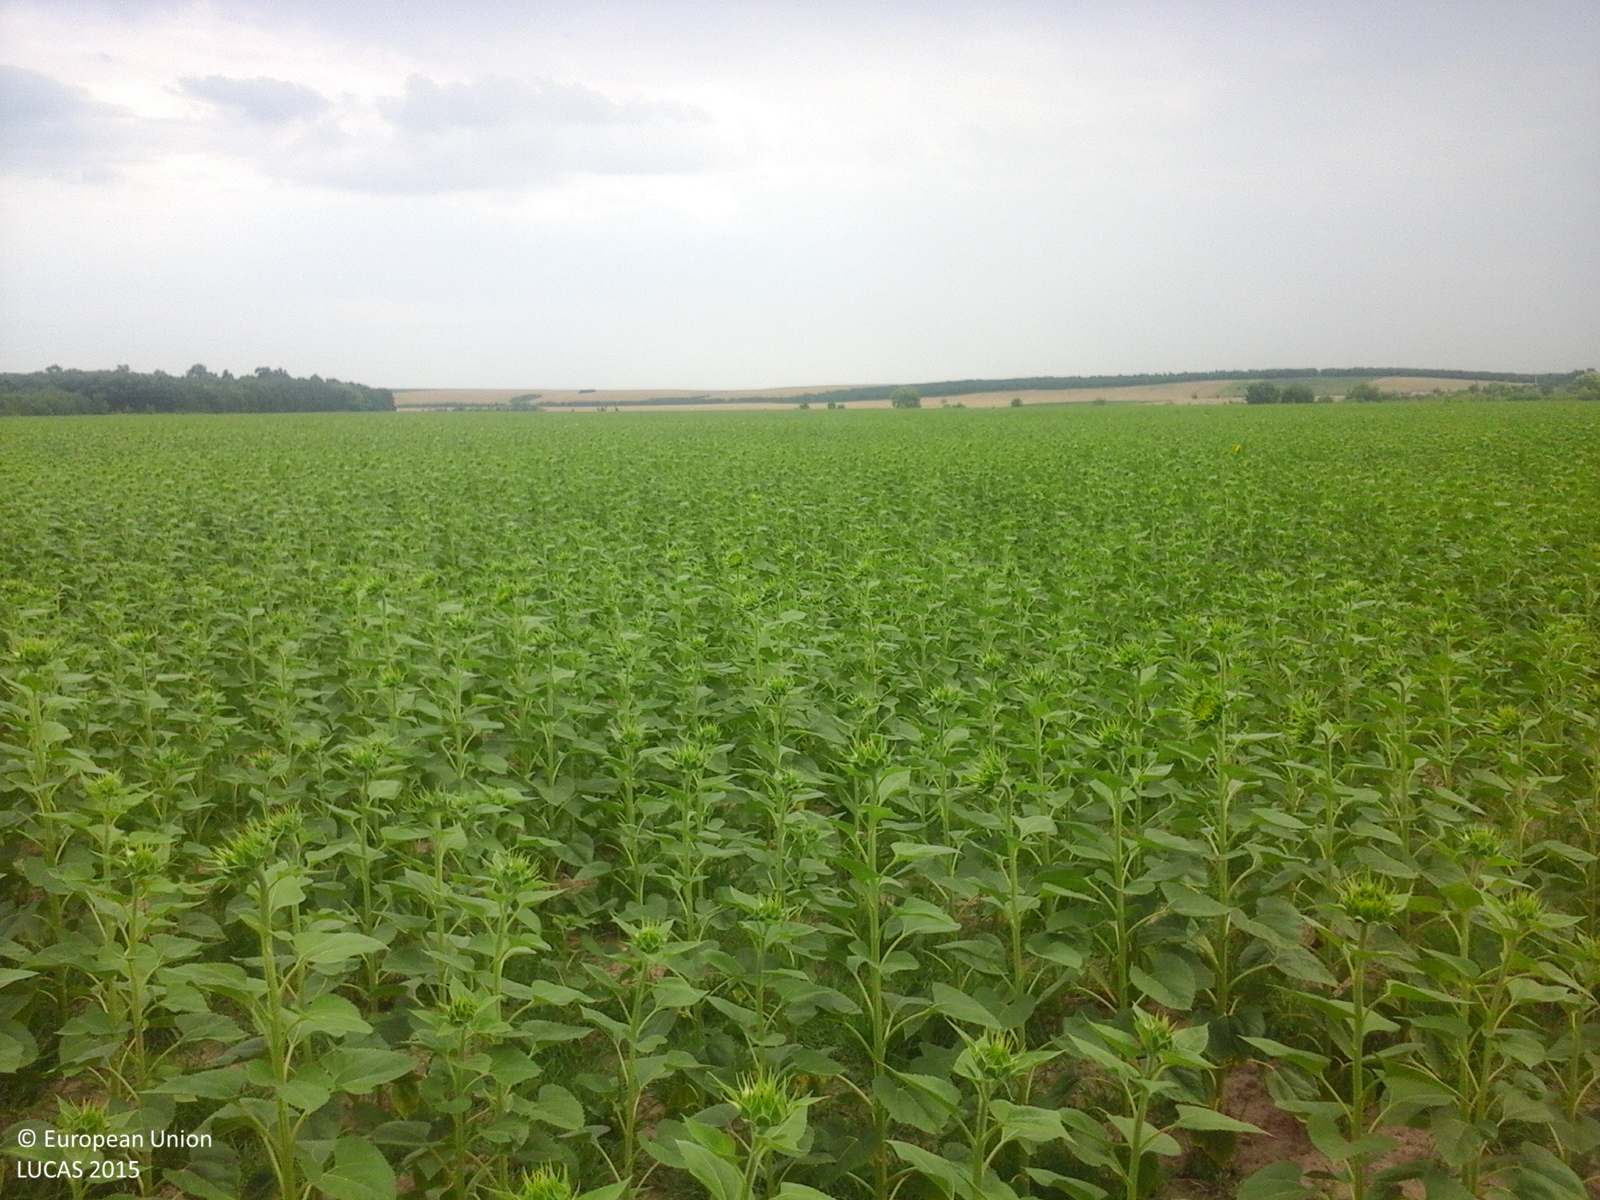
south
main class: Cropland
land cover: Sunflower
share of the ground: > 75 %
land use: Agriculture (excluding fallow land and kitchen gardens)
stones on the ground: < 10 %
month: June
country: RO
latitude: 44.2292
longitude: 25.9358
